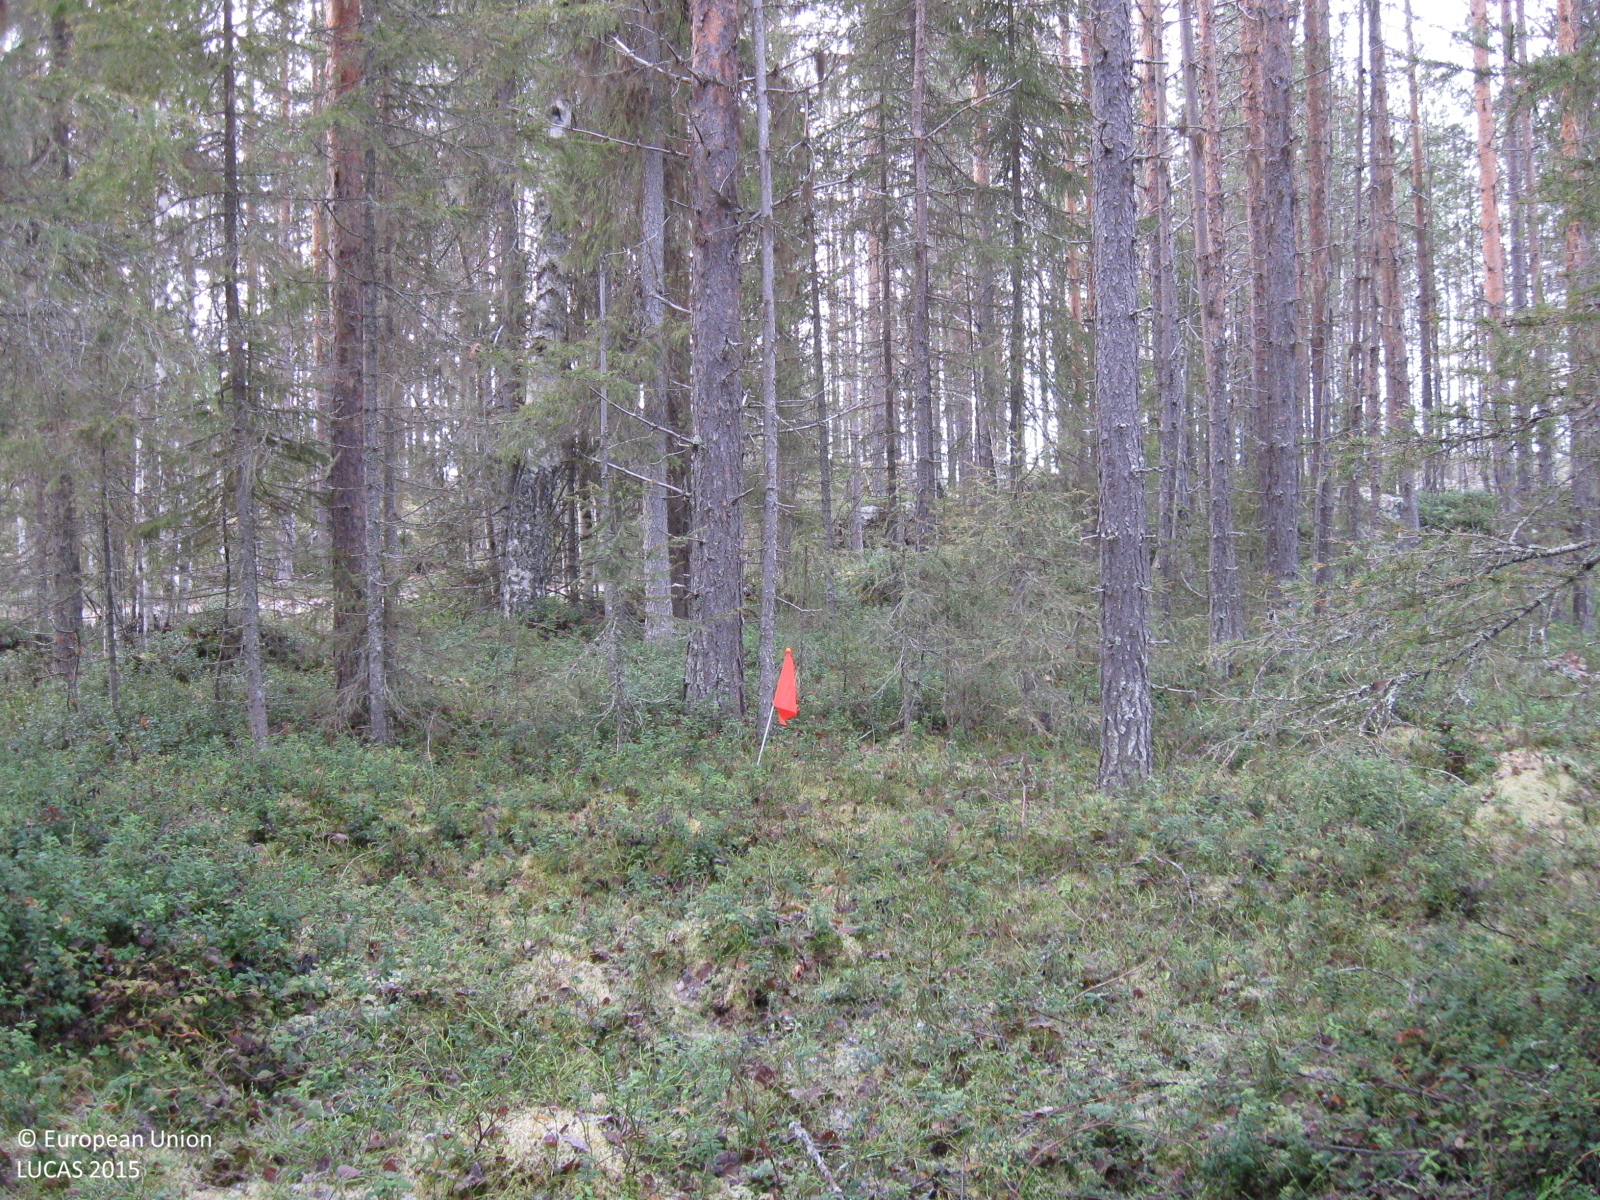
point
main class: Woodland
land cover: Other mixed woodland
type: boreal forest
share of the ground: > 75 %
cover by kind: coniferous forest trees 60 %, broadleaved forest trees 25 %, shrubs 5 %, herbaceous plants 5 %, lichens and mosses 5 %
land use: Forestry
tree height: > 5 m
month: October
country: SE
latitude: 66.2481
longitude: 21.5132
